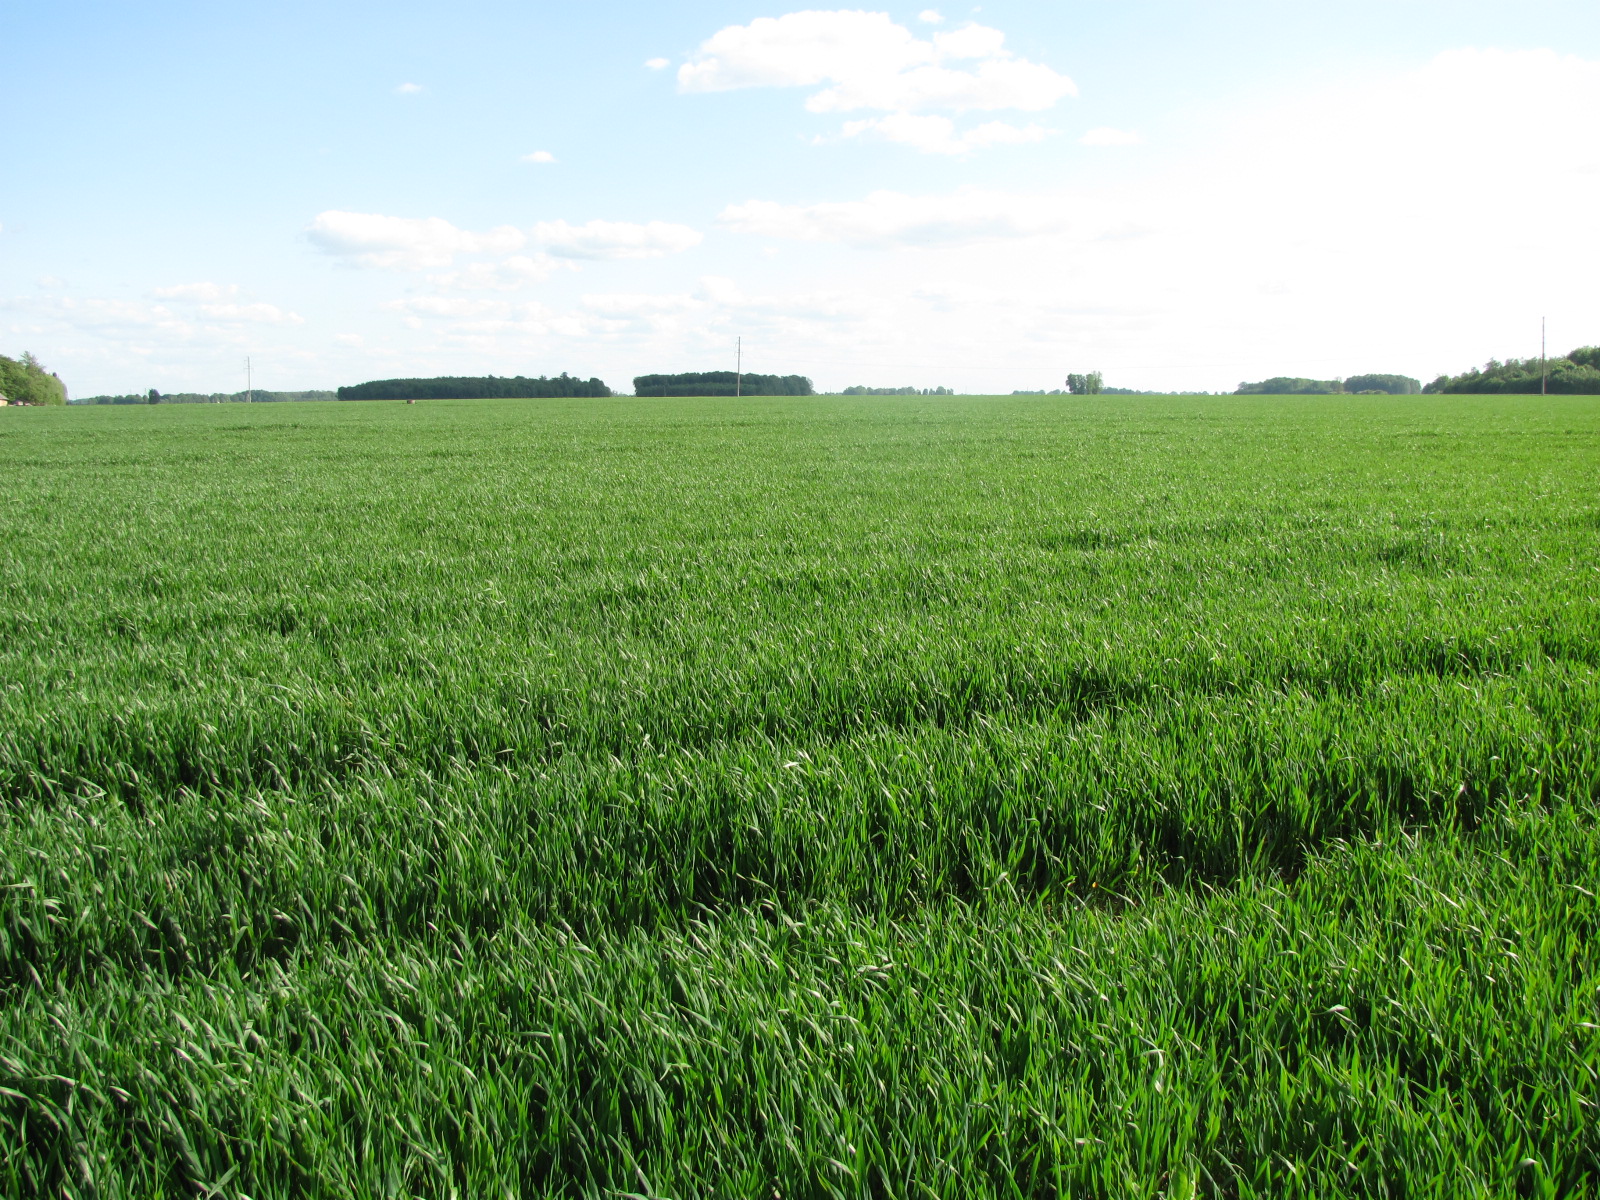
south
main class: Cropland
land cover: Common wheat
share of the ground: > 75 %
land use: Agriculture (excluding fallow land and kitchen gardens)
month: May
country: LV
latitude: 56.5423
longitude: 23.8903
